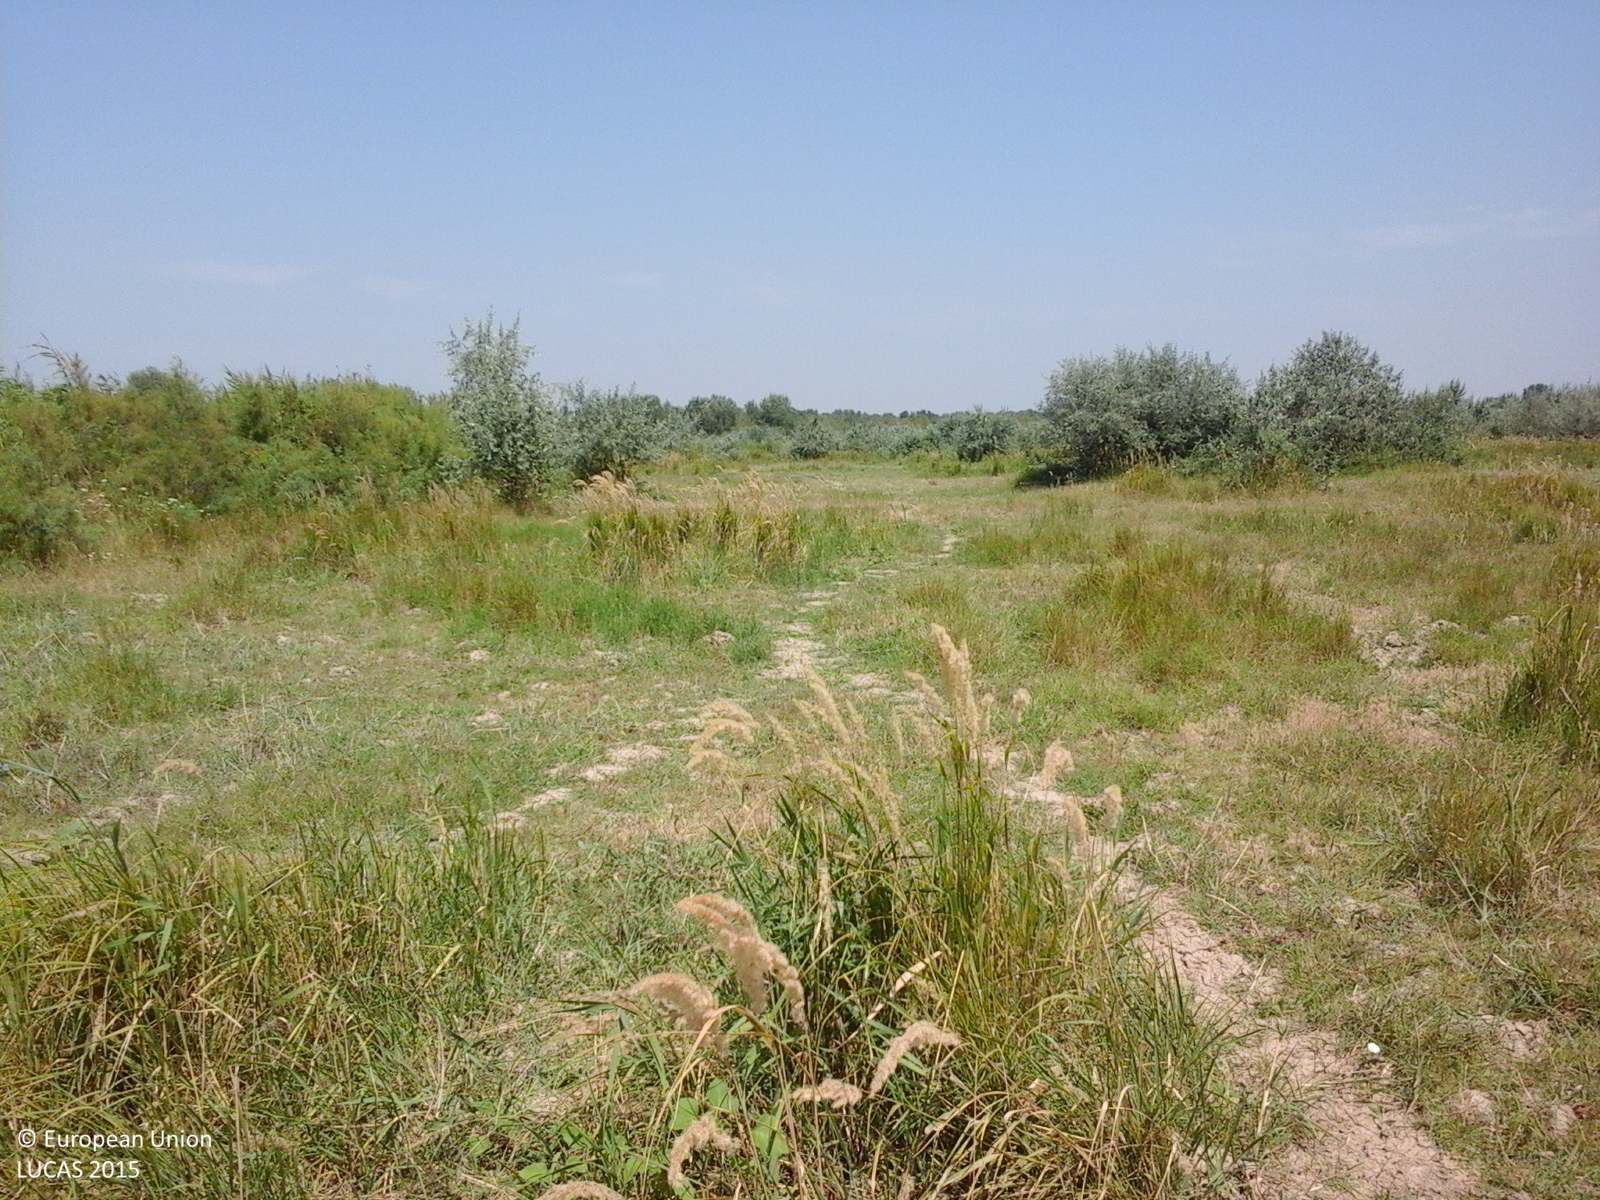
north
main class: Grassland
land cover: Spontaneously vegetated surfaces
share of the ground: > 75 %
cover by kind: herbaceous plants 100 %
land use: Agriculture (excluding fallow land and kitchen gardens)
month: August
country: RO
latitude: 45.2098
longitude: 27.3738
